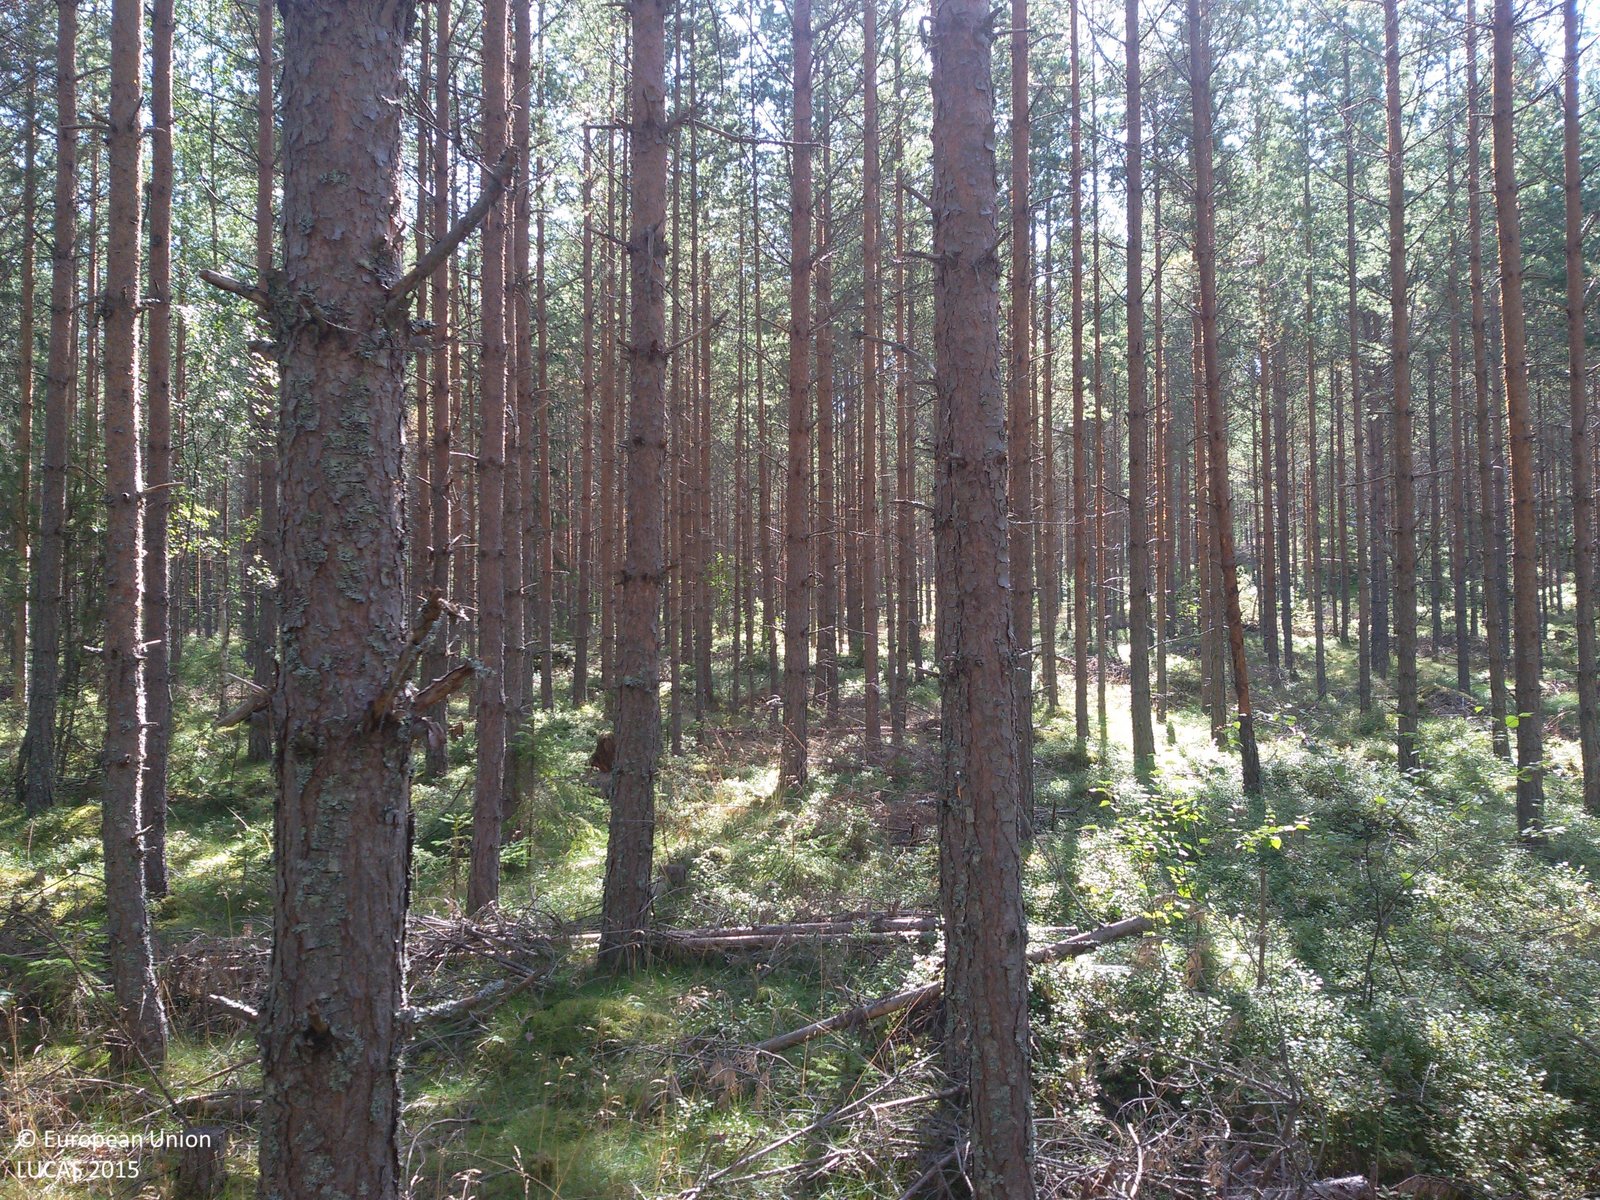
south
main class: Woodland
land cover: Pine dominated coniferous woodland
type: boreal forest
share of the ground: > 75 %
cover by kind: coniferous forest trees 80 %, herbaceous plants 15 %, lichens and mosses 5 %
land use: Forestry
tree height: > 5 m
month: August
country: SE
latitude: 60.6443
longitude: 15.6744
